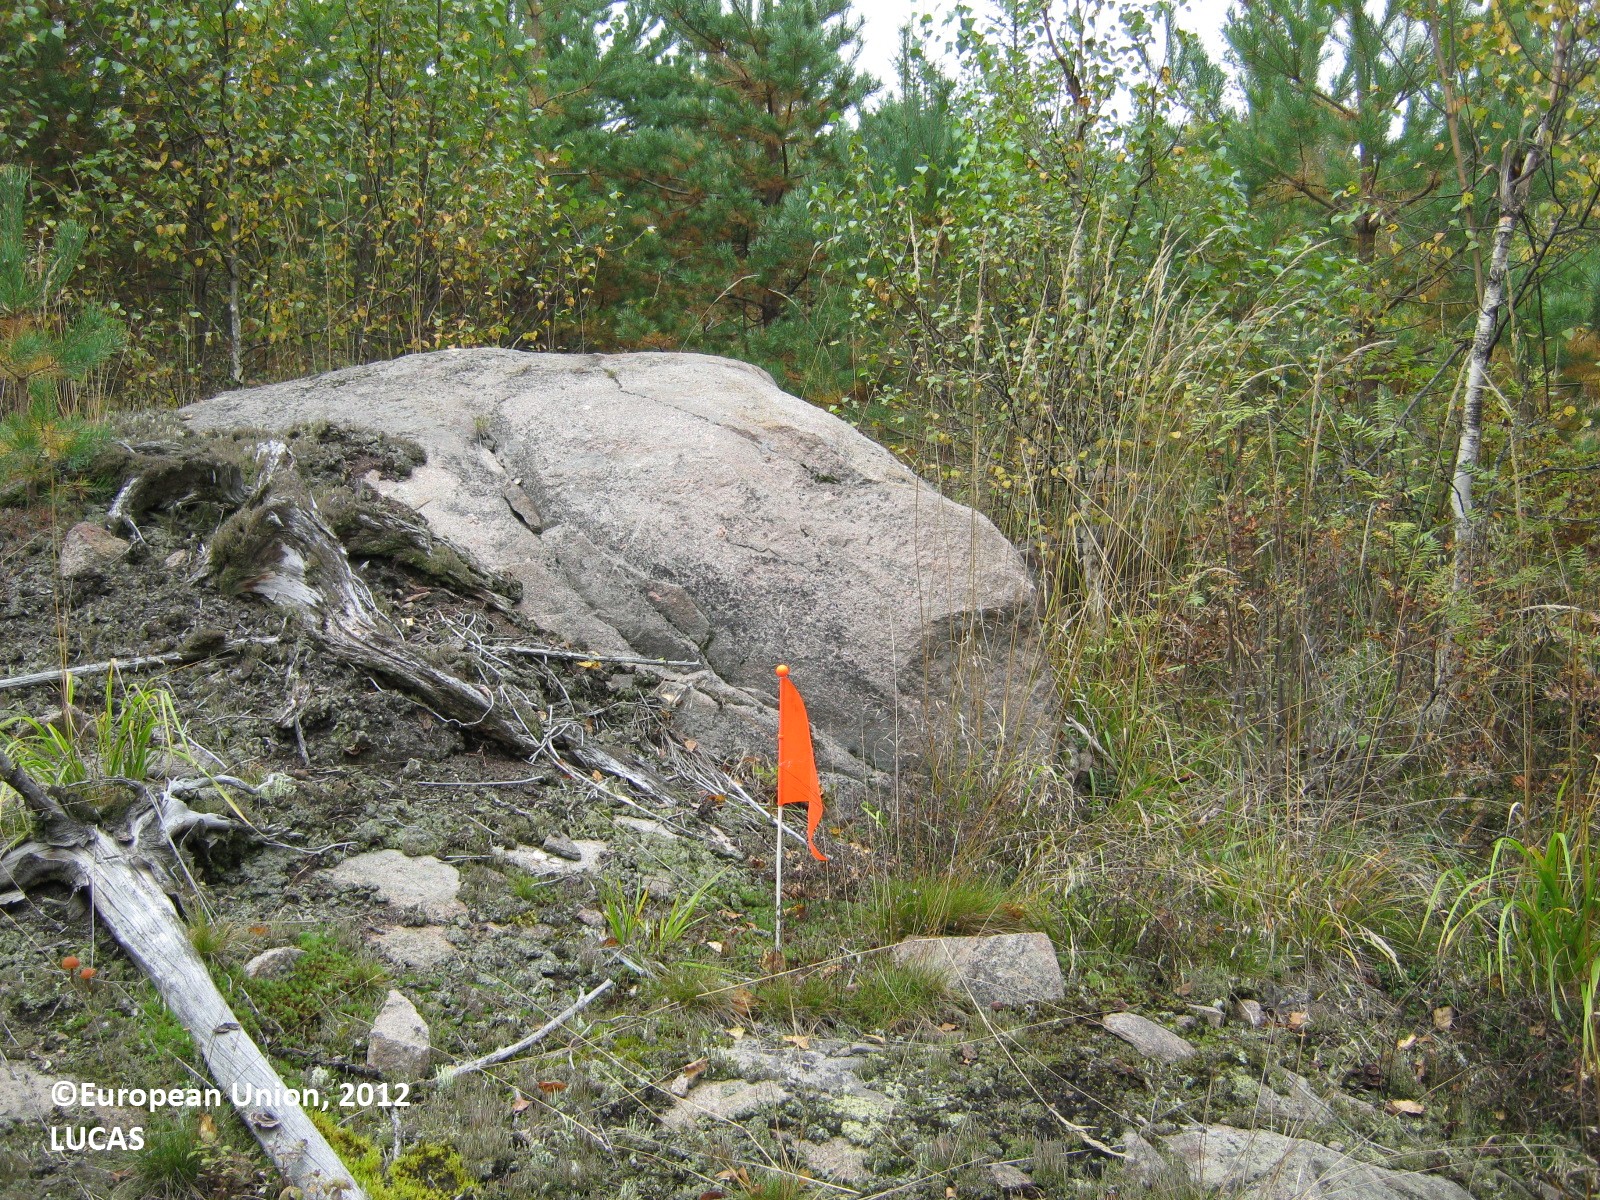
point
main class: Woodland
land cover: Pine dominated mixed woodland
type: boreal forest
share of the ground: > 75 %
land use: Forestry
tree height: < 5 m
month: September
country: FI
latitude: 60.8261
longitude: 28.1359
